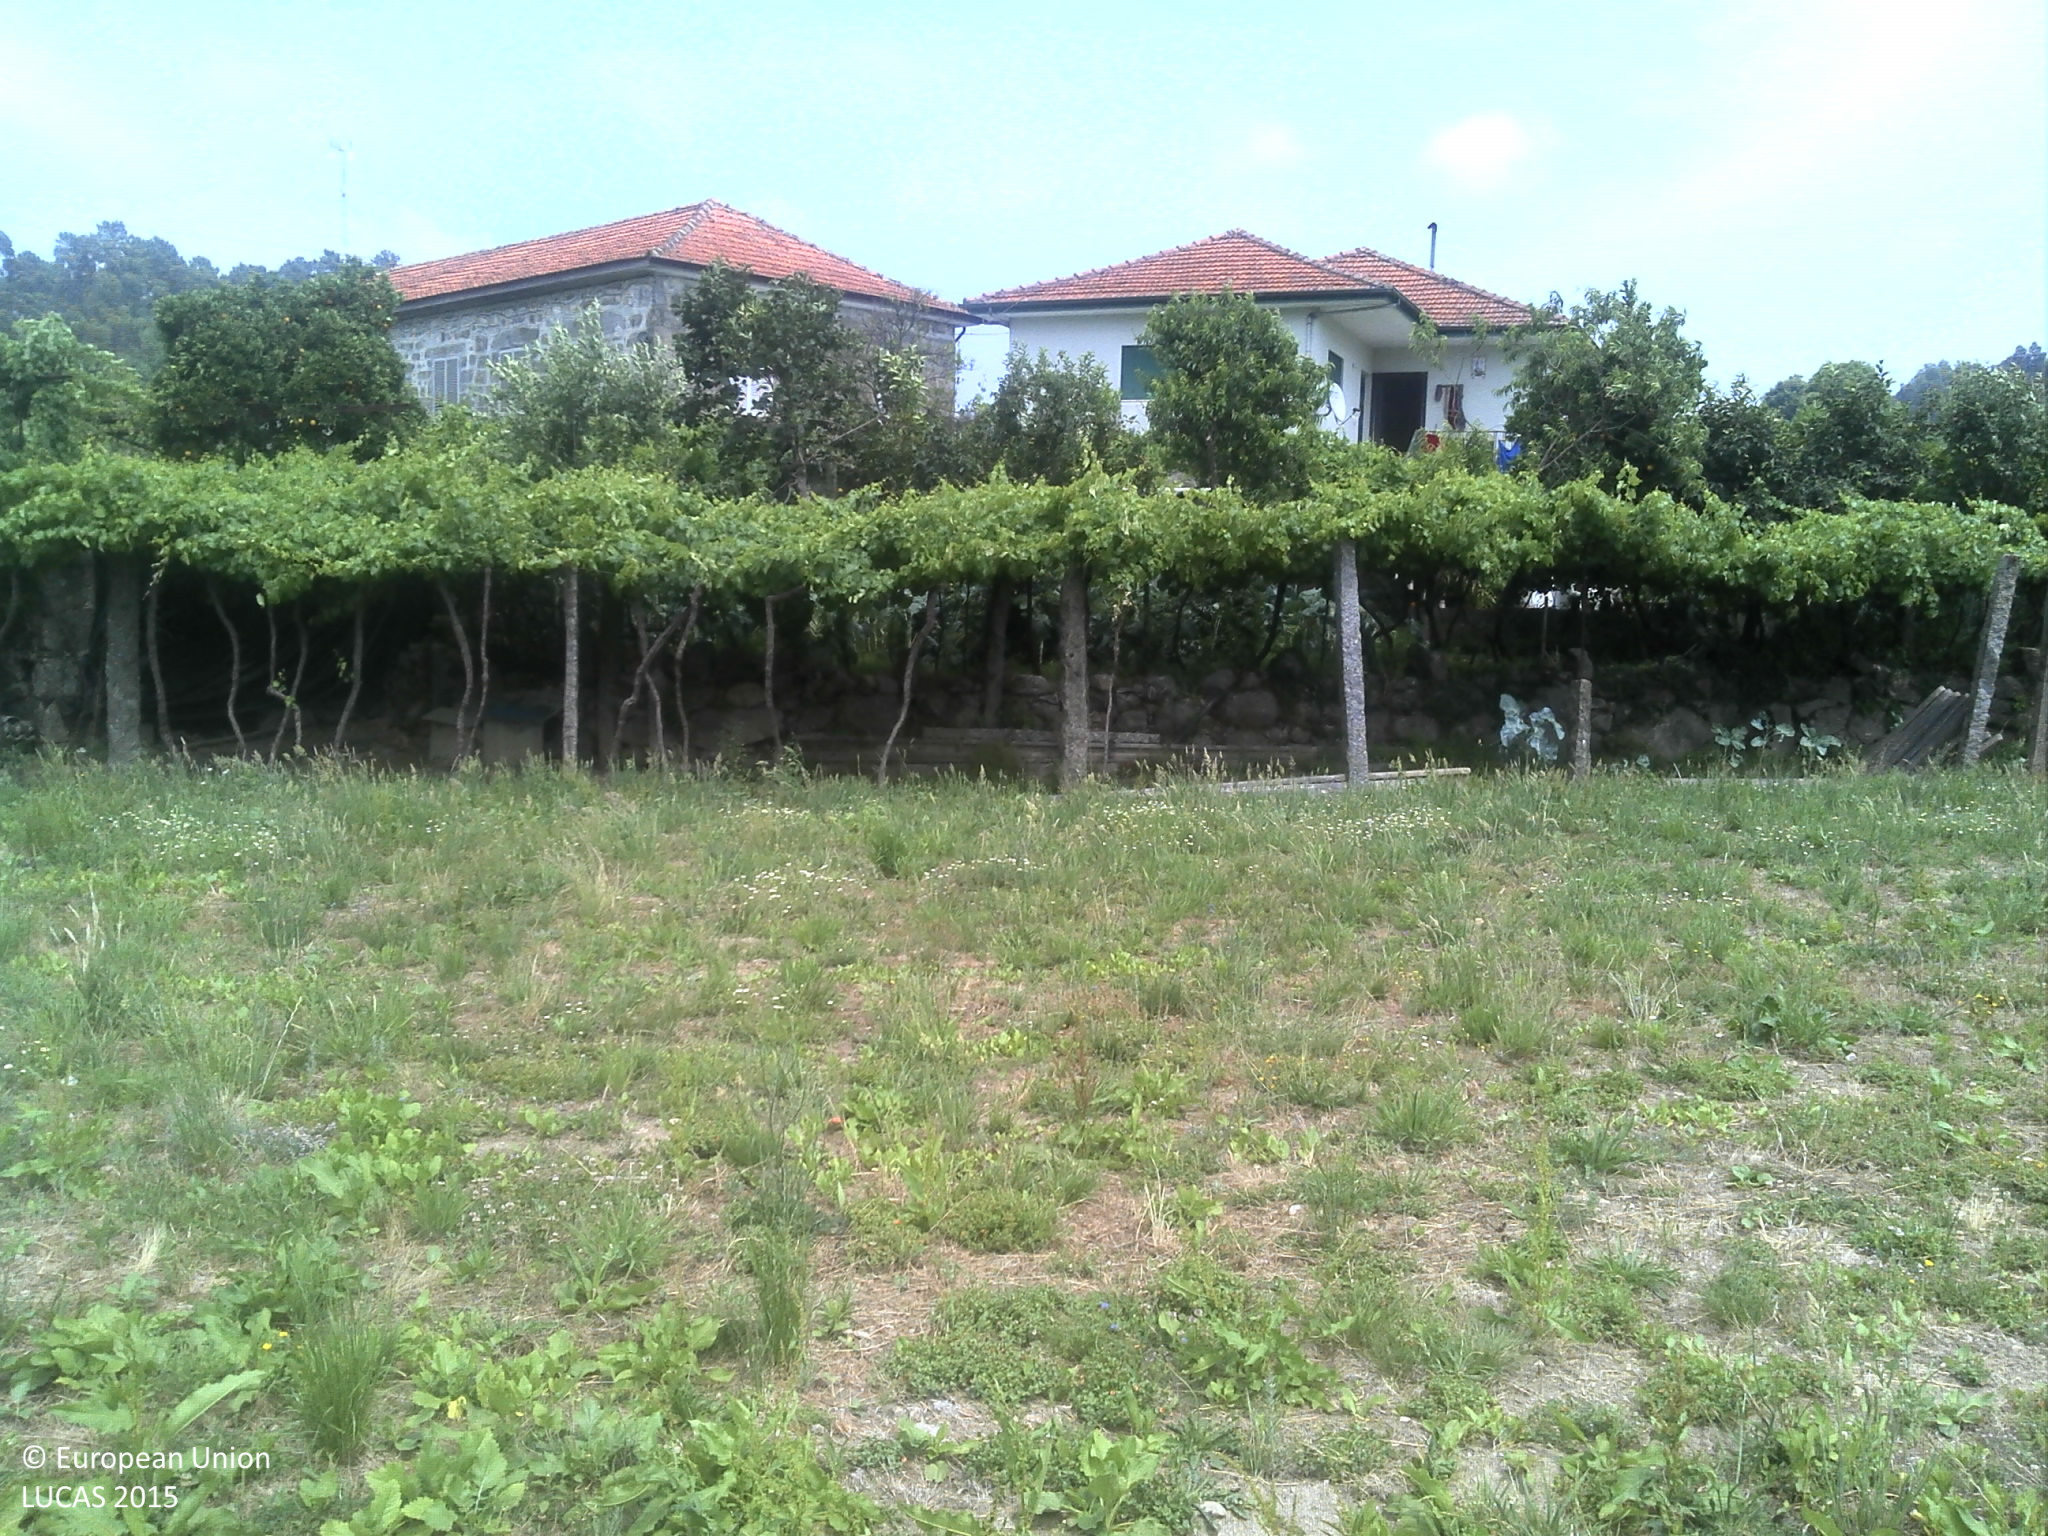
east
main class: Grassland
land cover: Spontaneously vegetated surfaces
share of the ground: 50 - 75 %
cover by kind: herbaceous plants 65 %, unconsolidated bare surface 35 %
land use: Fallow land
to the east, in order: Spontaneously vegetated surfaces; Vineyards; Dry stone walls; Other fruit trees and berries; Artificial constructions in urban areas; Maize; Tracks; Vineyards; Rivers and streams; Vineyards; Maize; Vineyards; Other fresh vegetables; Vineyards; Other fresh vegetables; Artificial constructions in urban areas; Other fresh vegetables; Vineyards; Abandoned hedges; Other bare soil
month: June
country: PT
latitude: 41.3262
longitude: -8.1717
